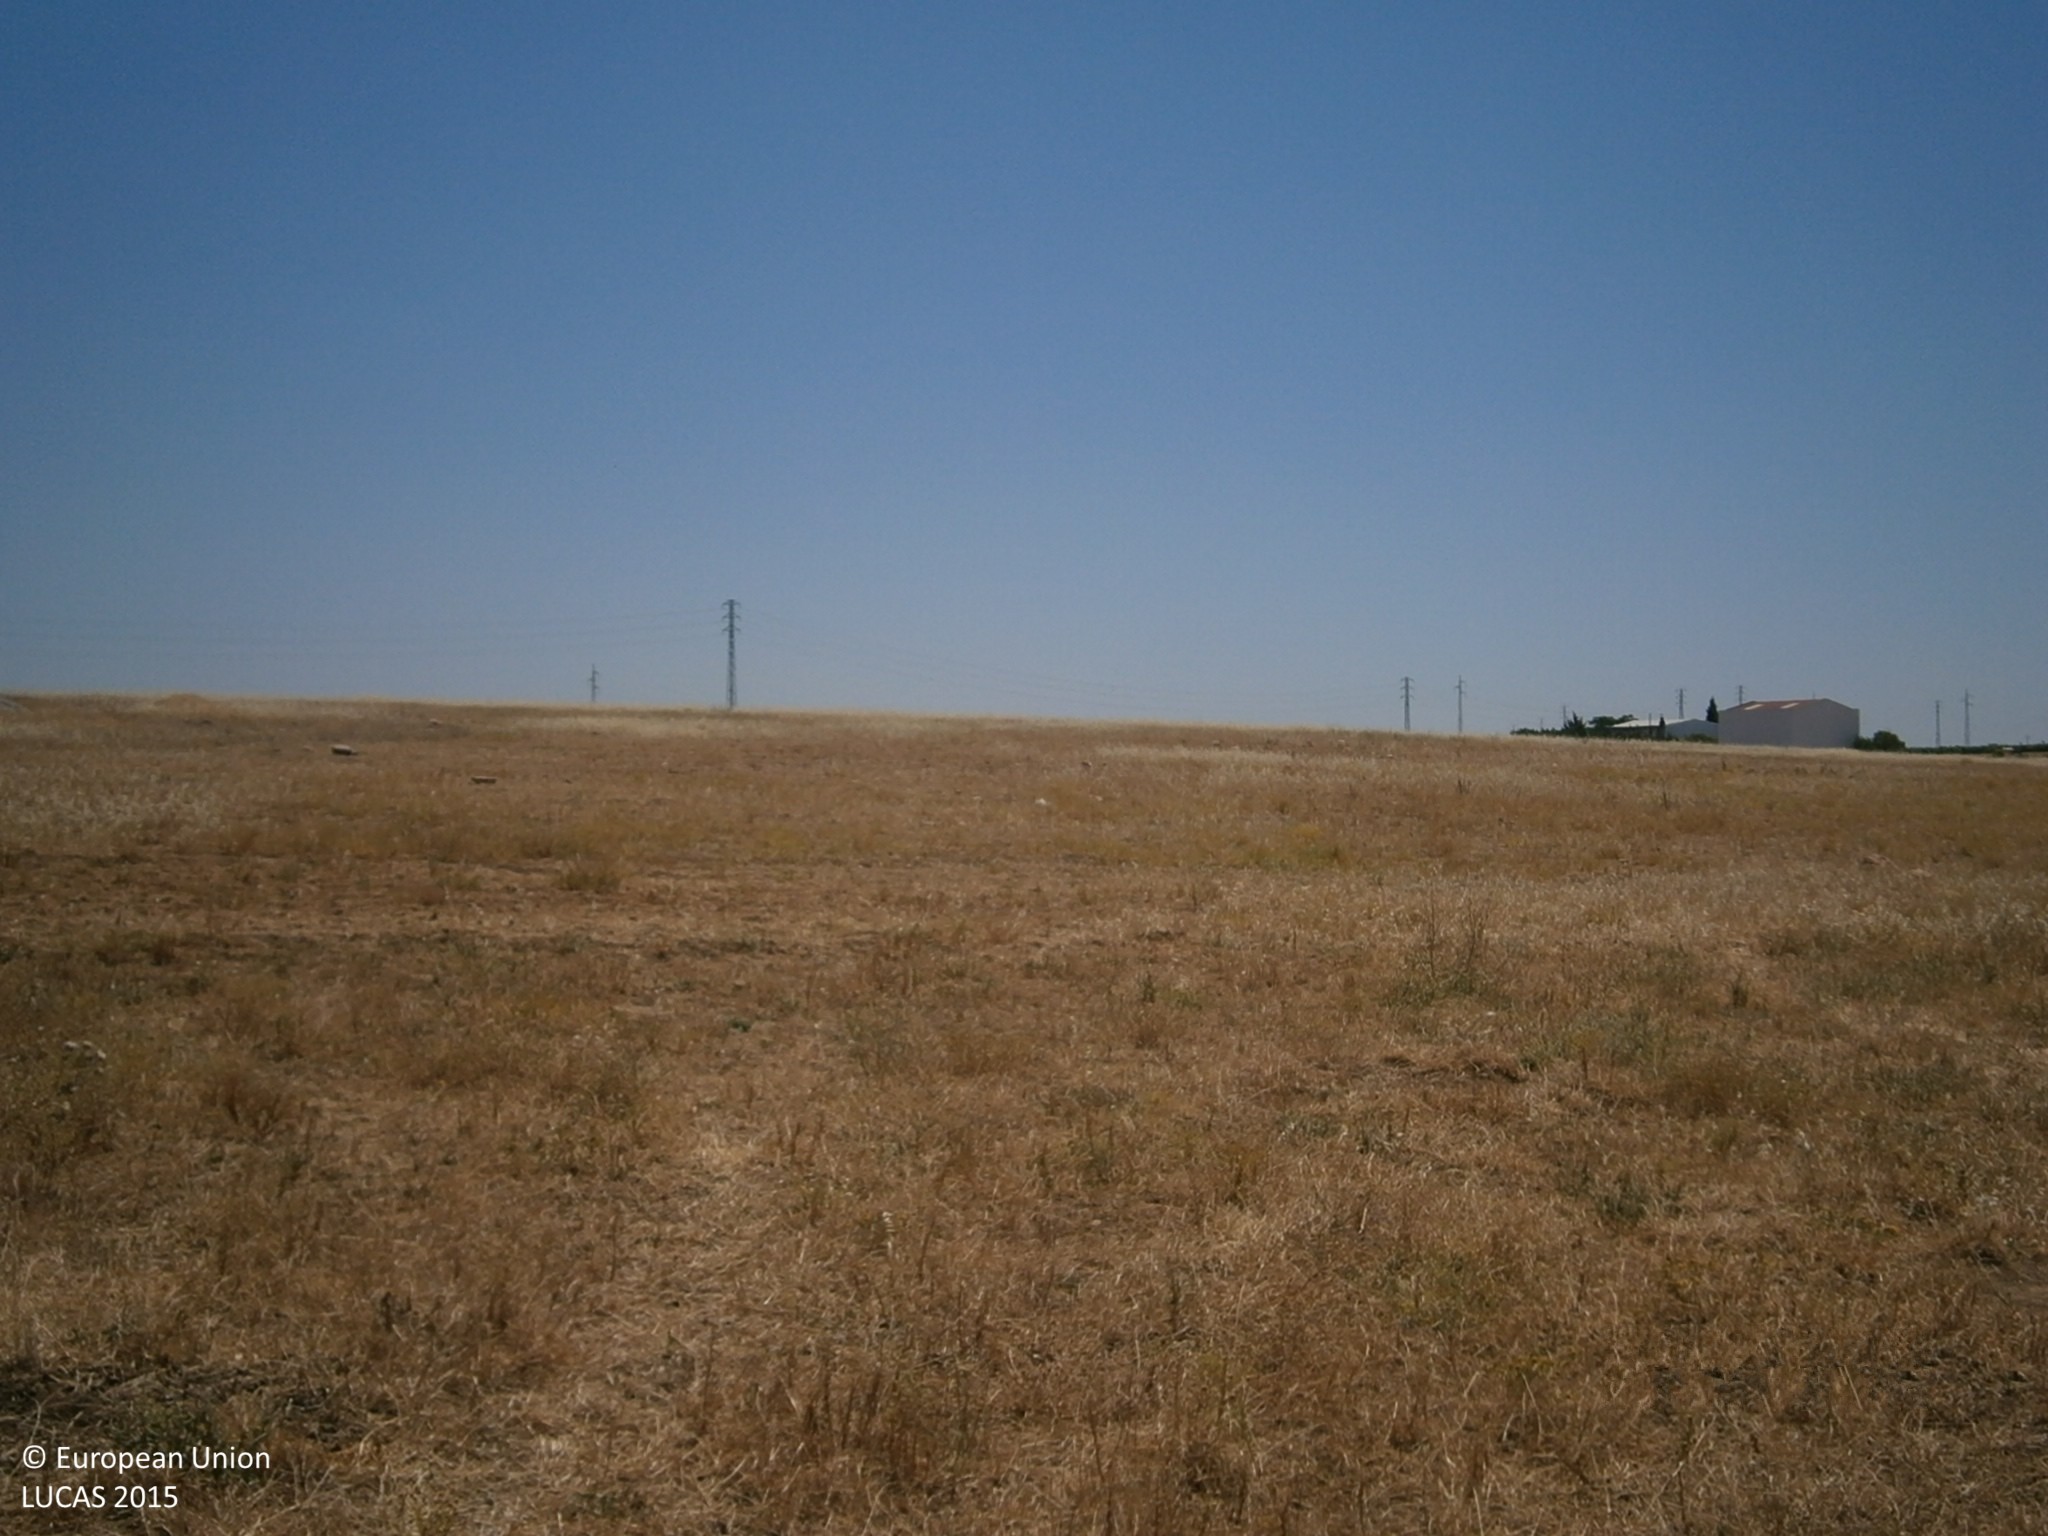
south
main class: Grassland
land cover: Grassland without tree/shrub cover
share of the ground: > 75 %
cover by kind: herbaceous plants 95 %
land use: Agriculture (excluding fallow land and kitchen gardens)
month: June
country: ES
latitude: 38.6761
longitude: -6.3879
